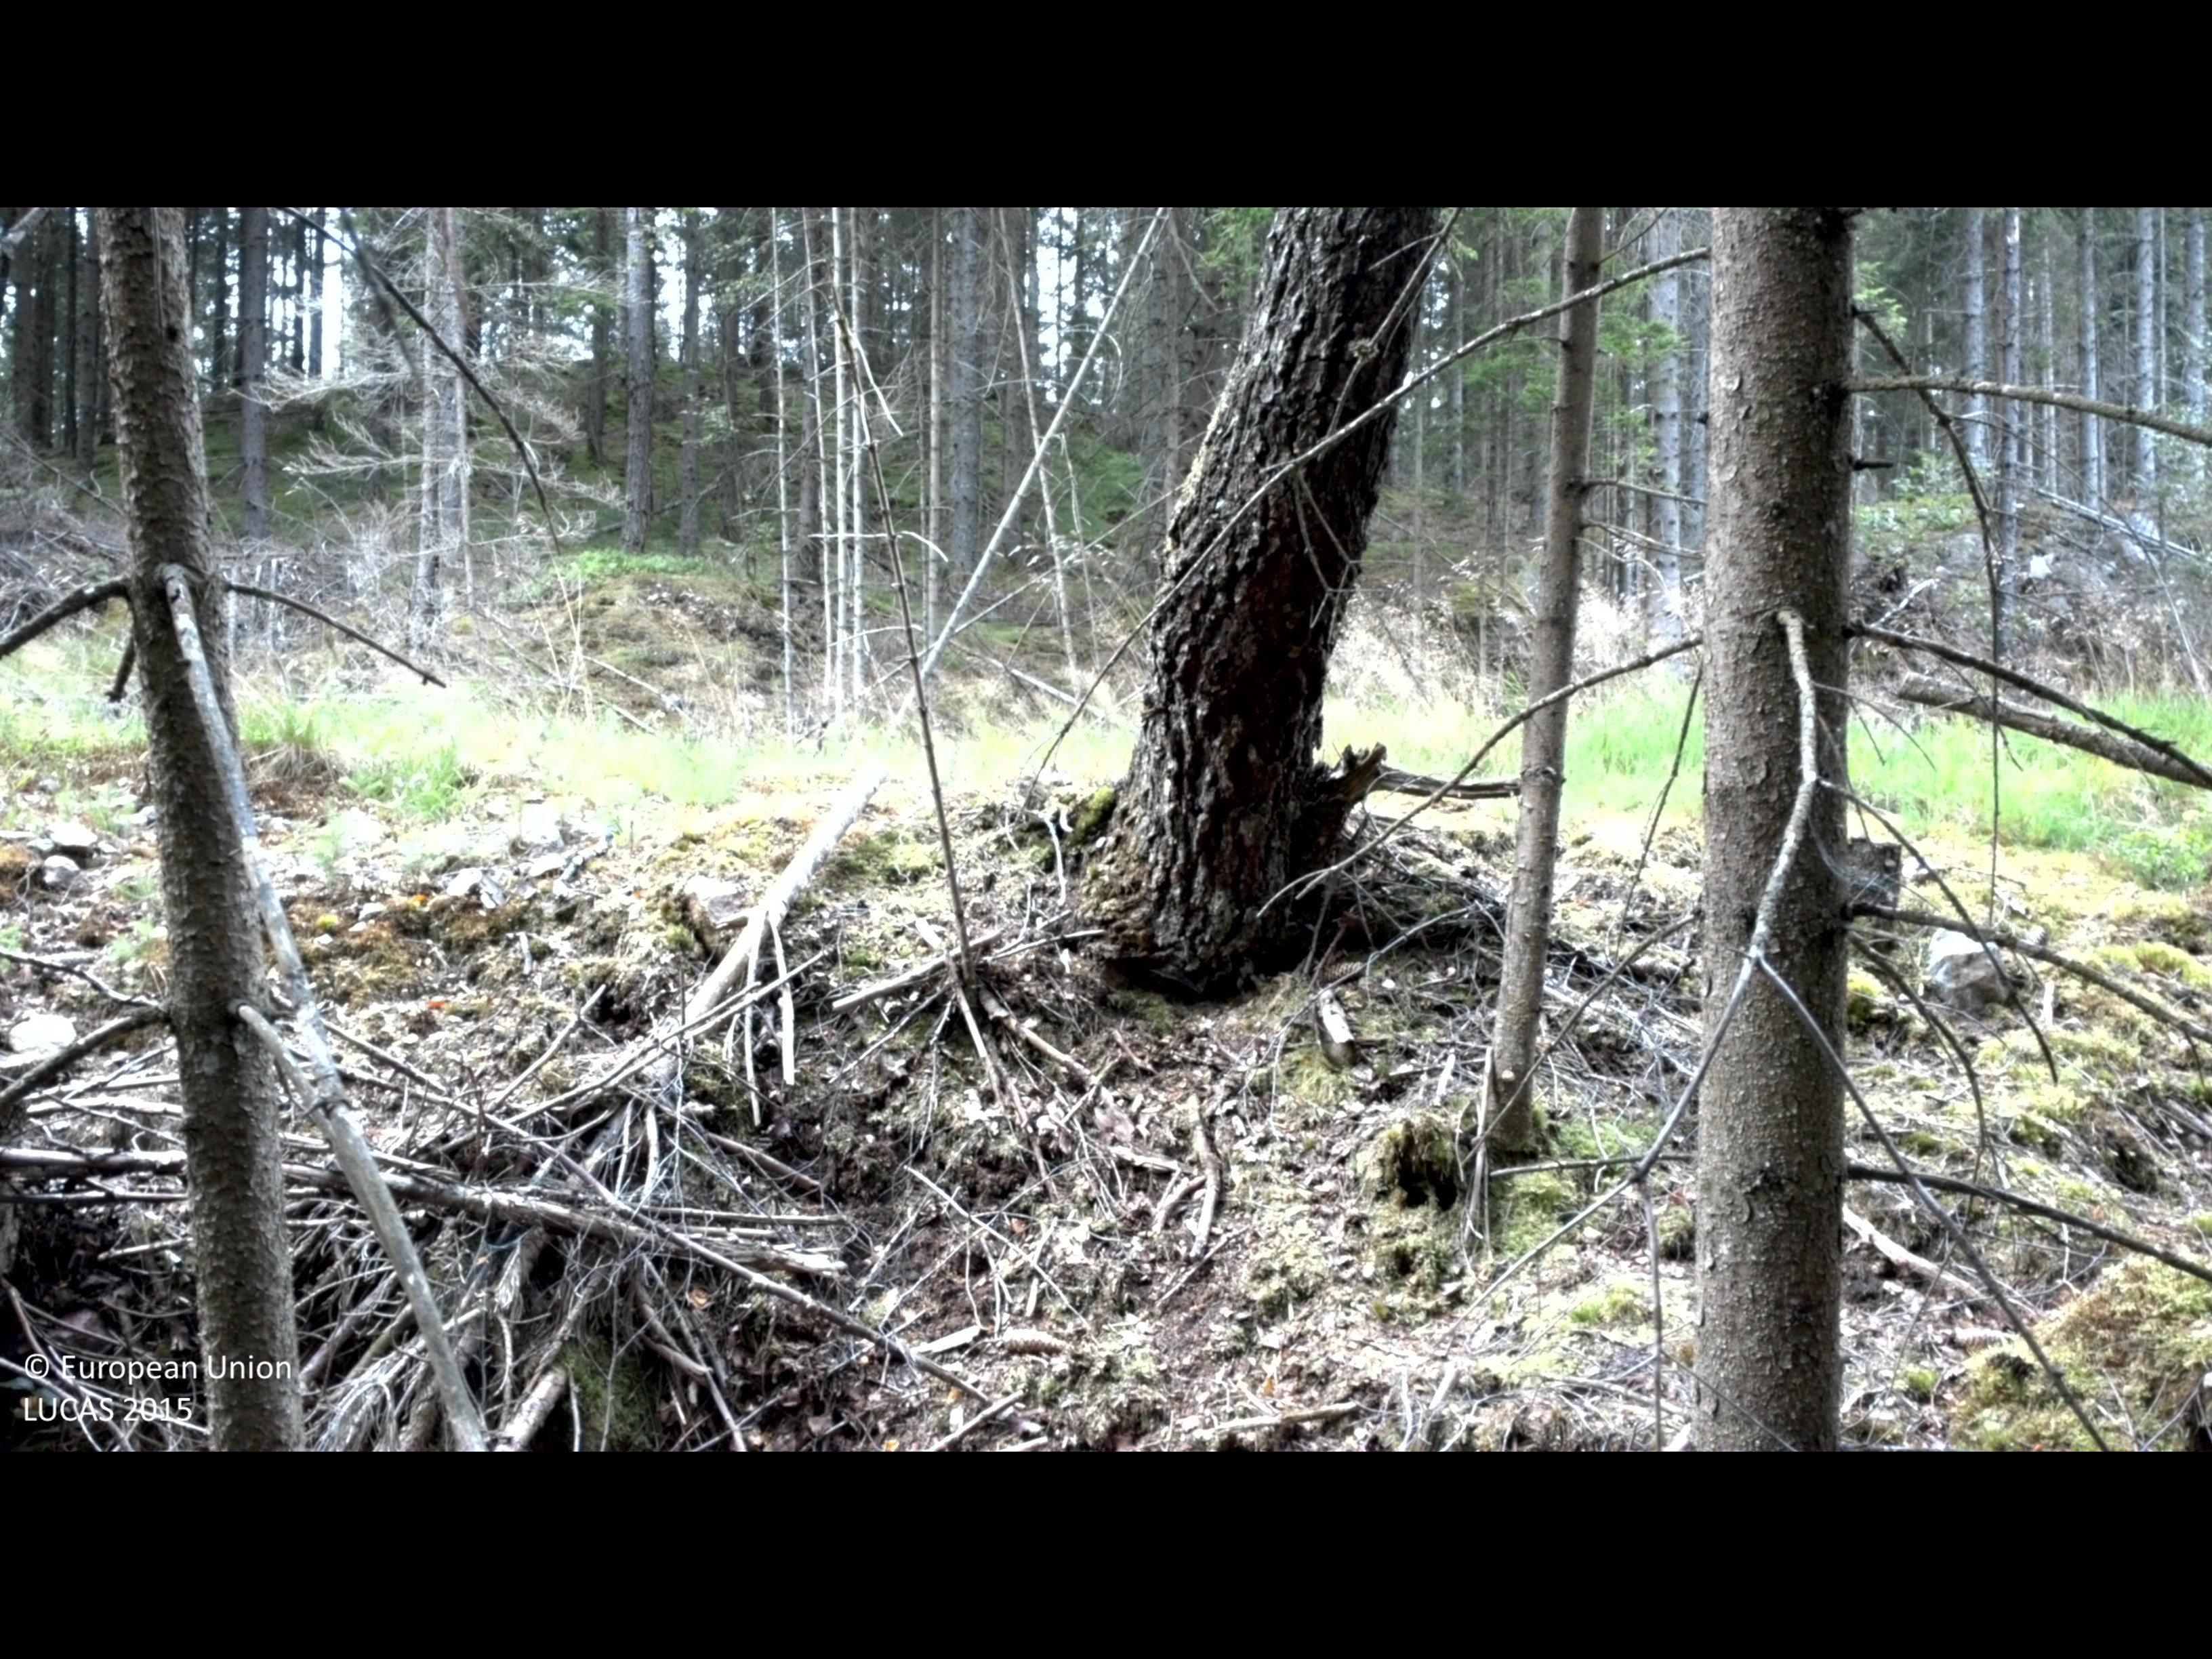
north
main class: Woodland
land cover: Spruce dominated coniferous woodland
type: boreal forest
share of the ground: > 75 %
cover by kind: coniferous forest trees 70 %, lichens and mosses 25 %, broadleaved forest trees 5 %
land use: Forestry
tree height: > 5 m
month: August
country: SE
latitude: 56.8318
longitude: 13.1924
